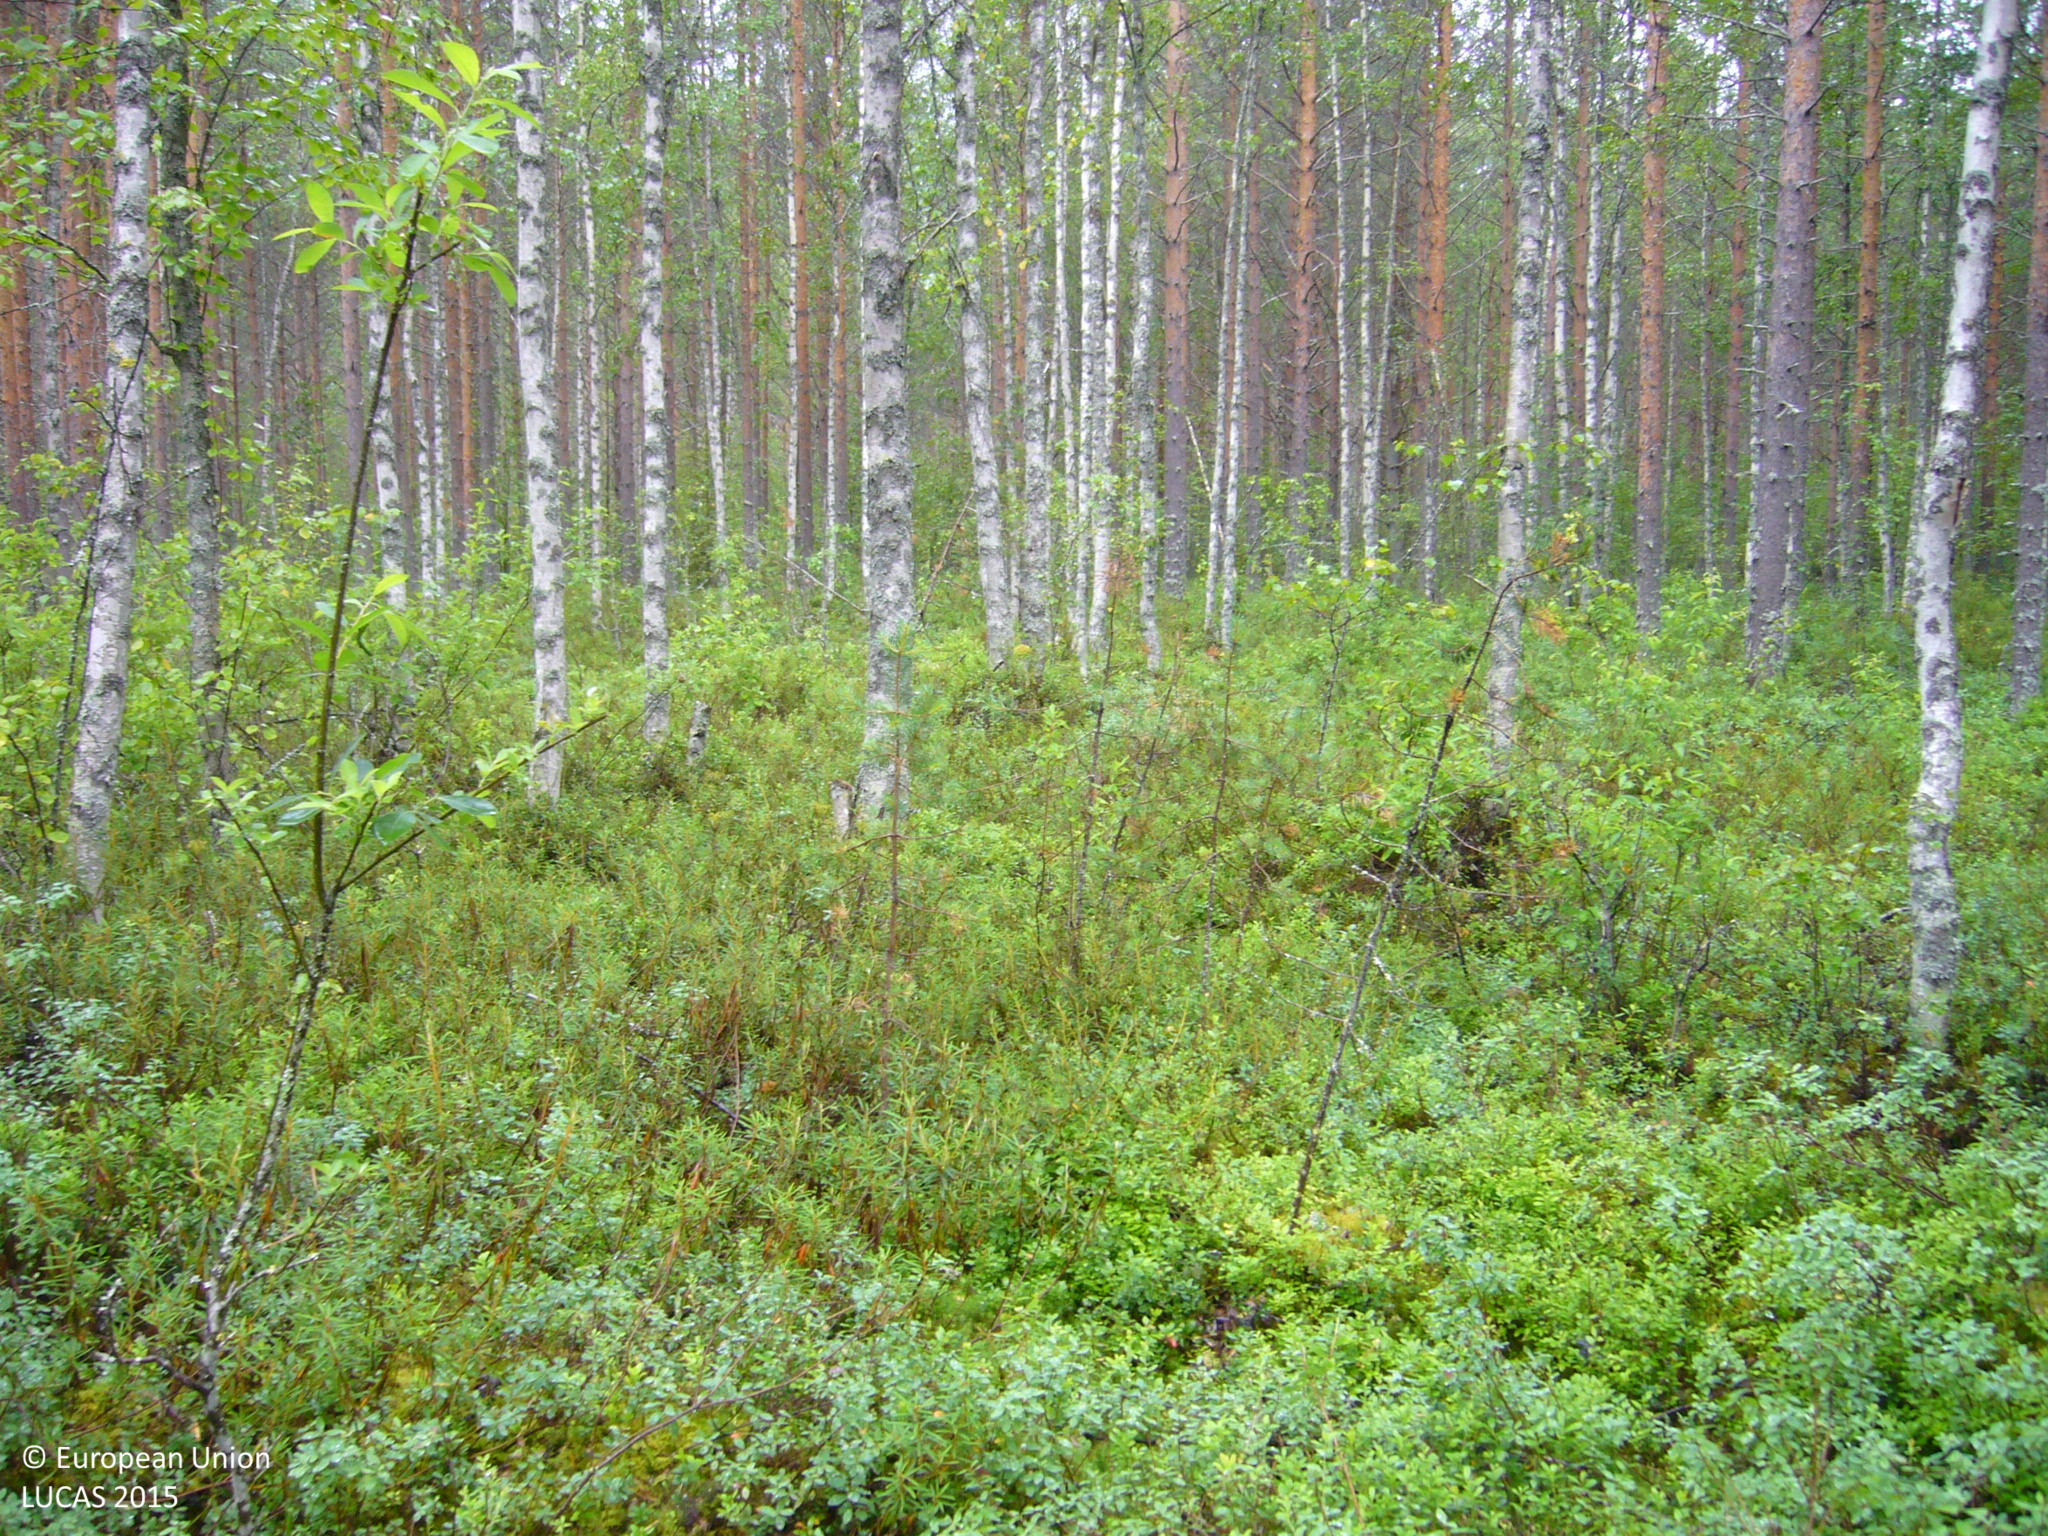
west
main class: Woodland
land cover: Pine dominated mixed woodland
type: boreal forest
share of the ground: 50 - 75 %
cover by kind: coniferous forest trees 40 %, broadleaved forest trees 30 %, shrubs 30 %
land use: Forestry
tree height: > 5 m
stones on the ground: 25 - 50 %
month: July
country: FI
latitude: 64.1668
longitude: 26.2164
